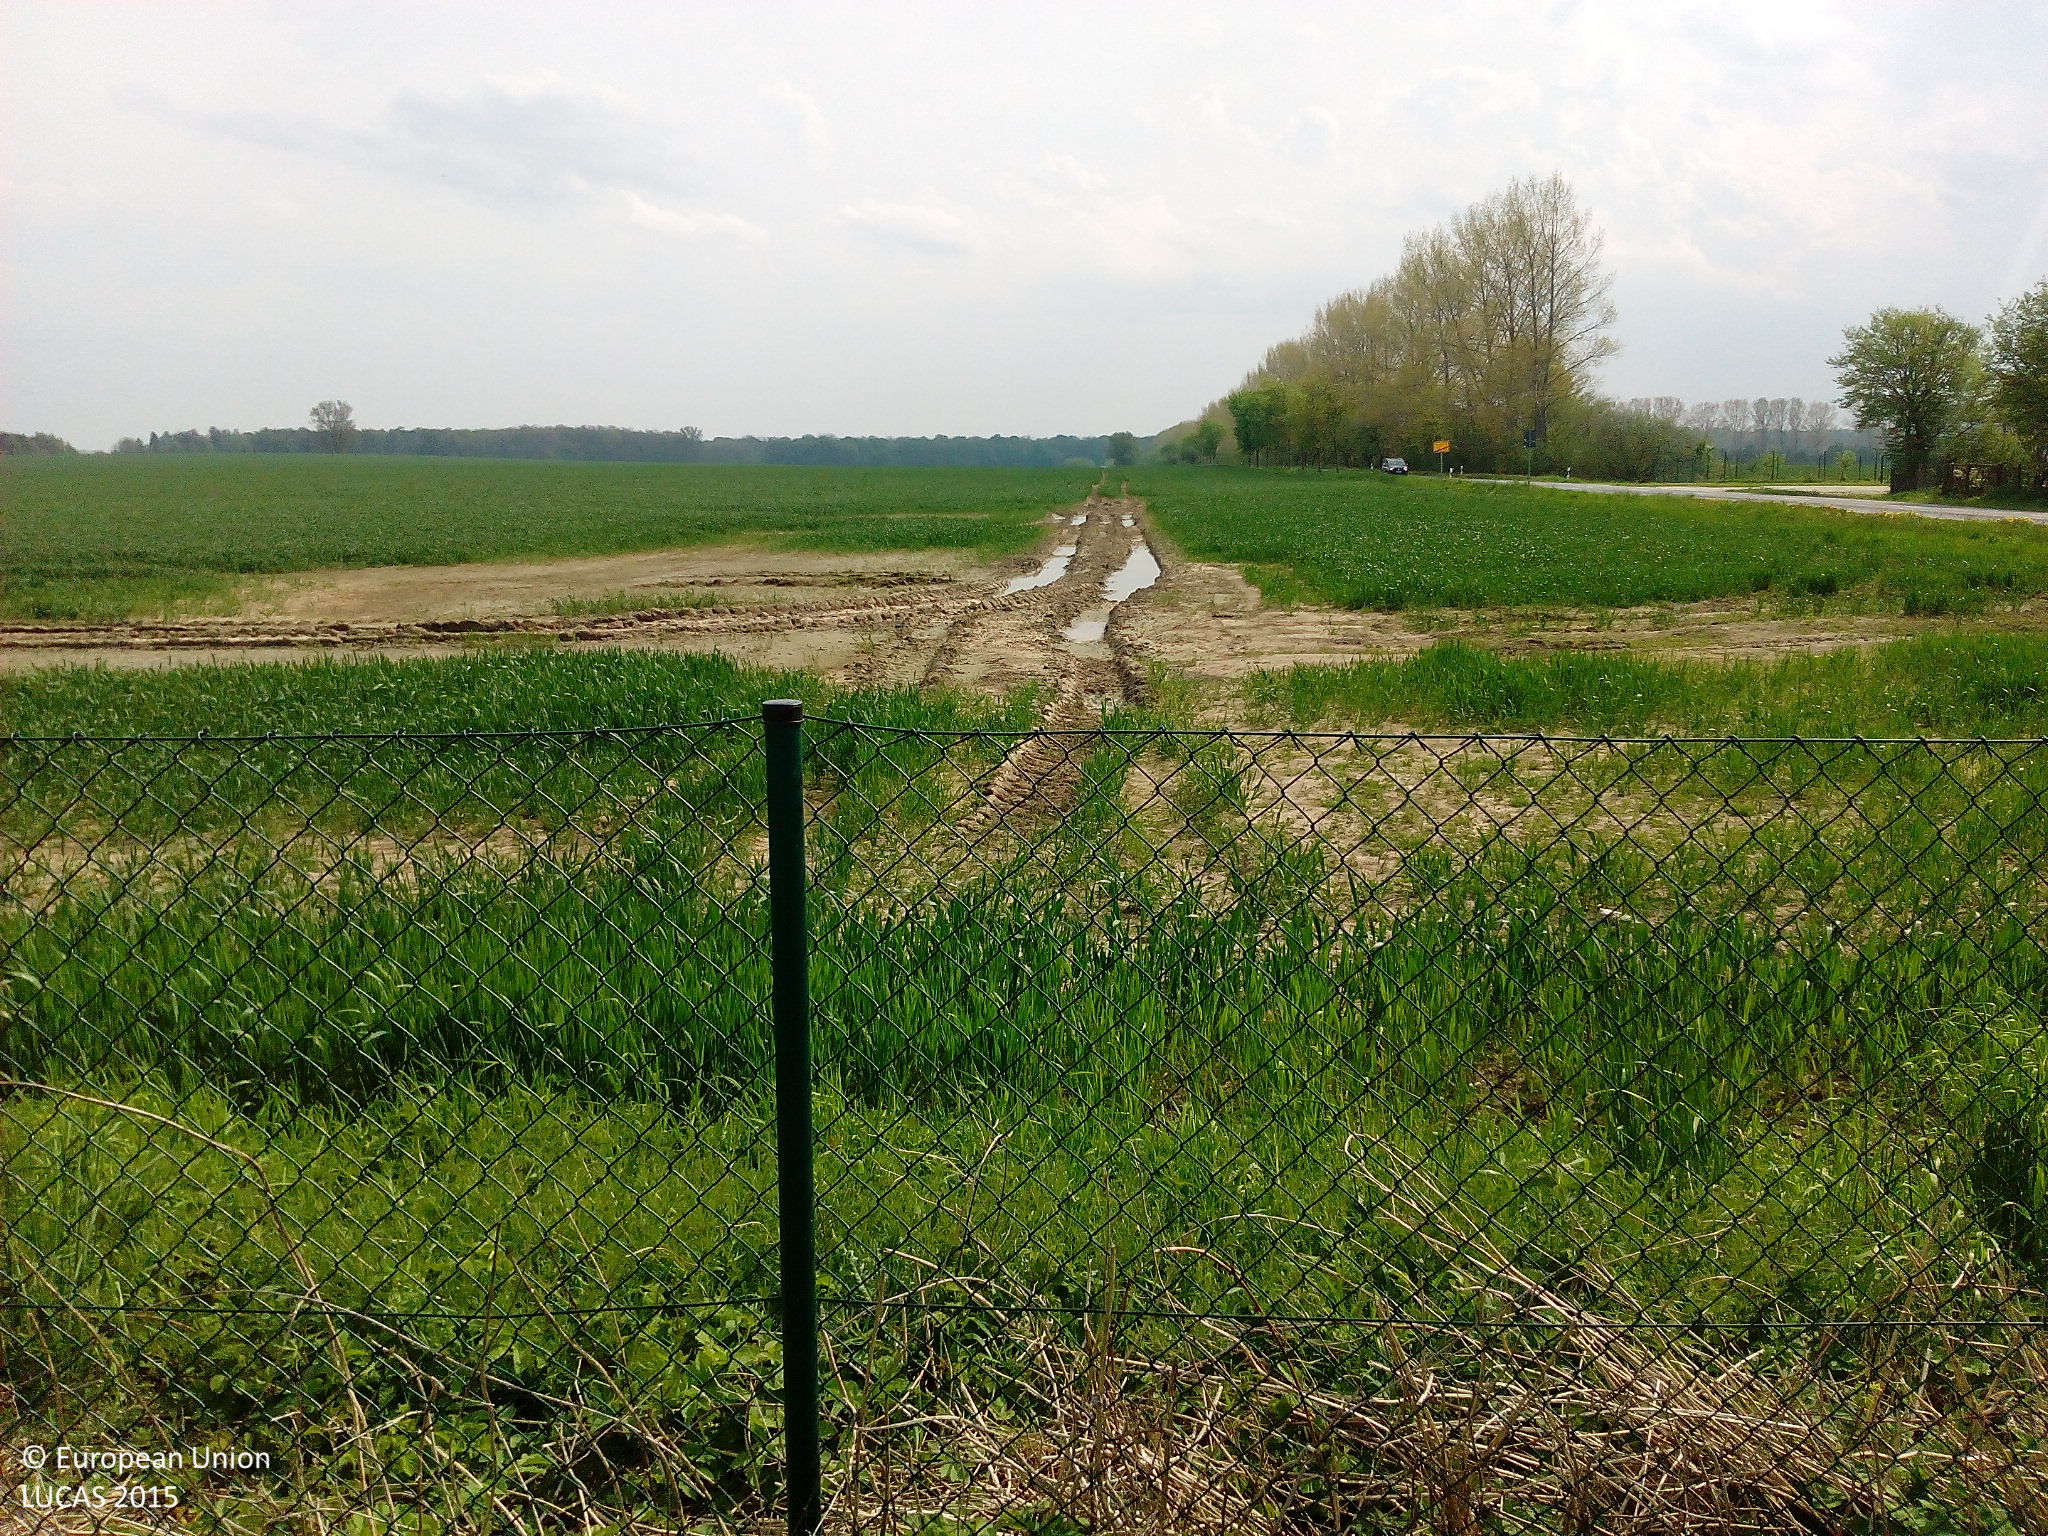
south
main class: Artificial land
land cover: Non built-up area features
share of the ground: > 75 %
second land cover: Grassland without tree/shrub cover
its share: > 75 %
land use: Commerce
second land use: Road transport
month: May
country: DE
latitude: 54.2886
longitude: 12.7181
